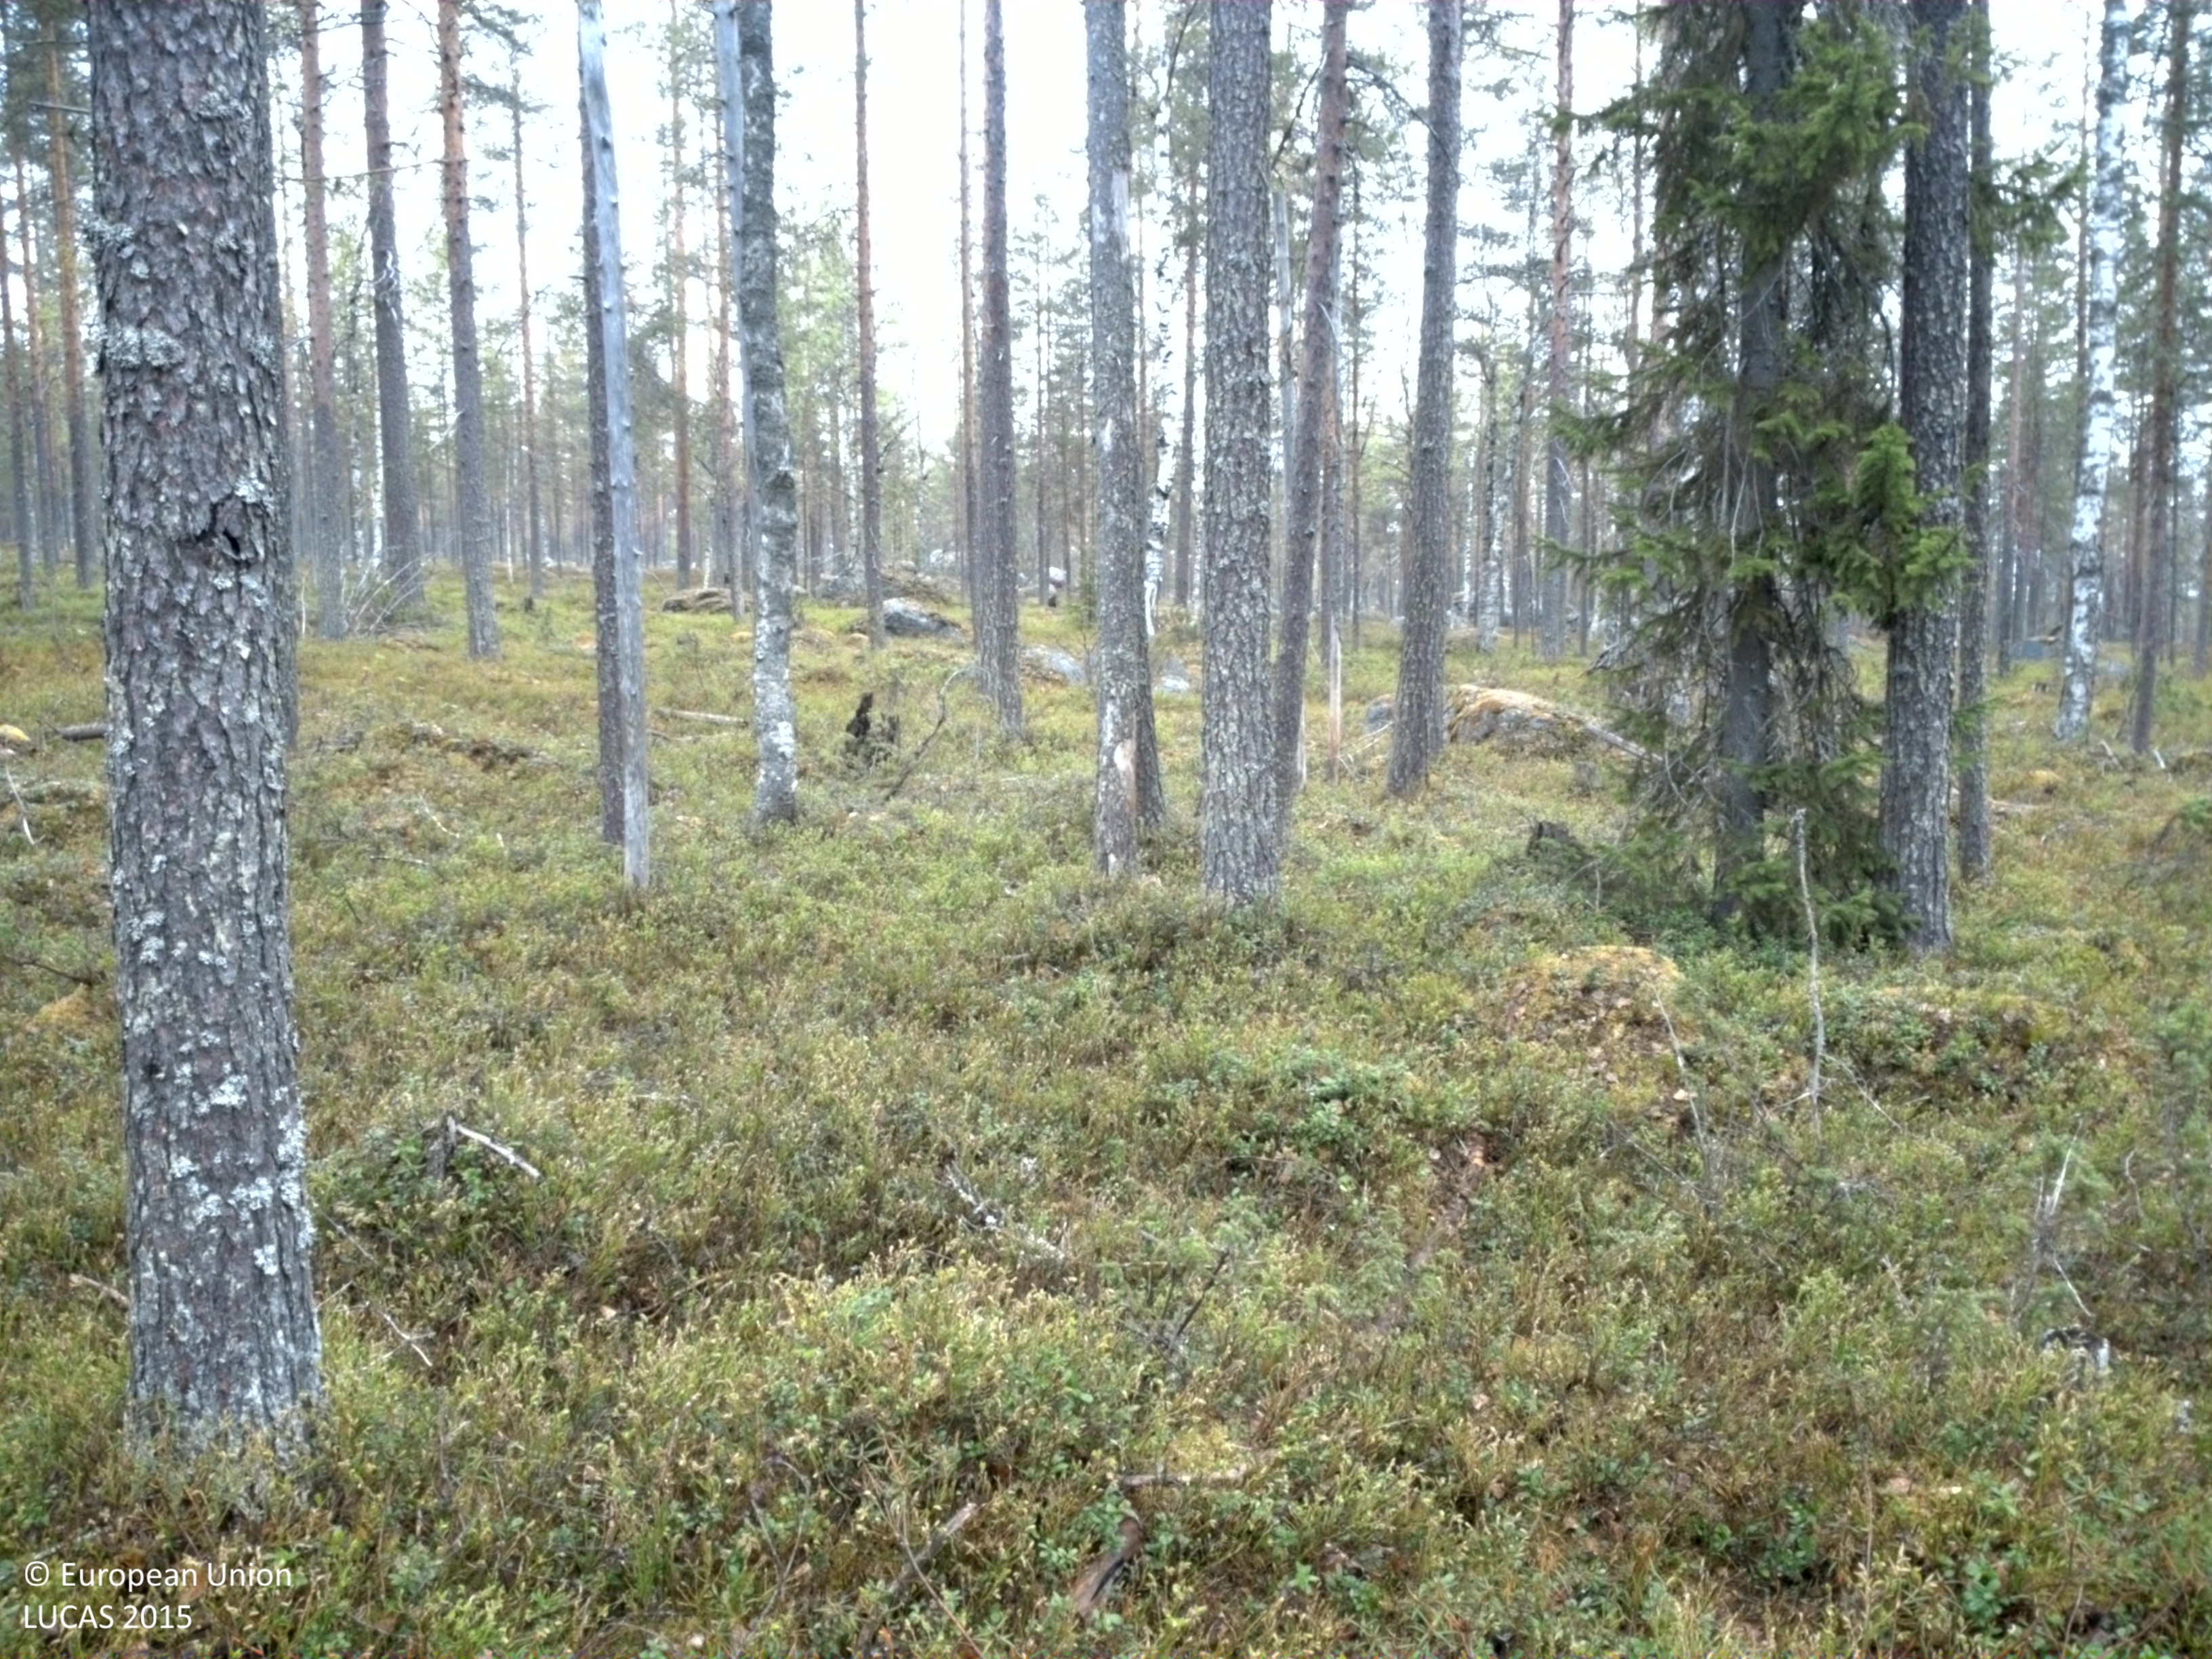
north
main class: Woodland
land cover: Pine dominated coniferous woodland
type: boreal forest
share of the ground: 50 - 75 %
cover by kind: coniferous forest trees 65 %, shrubs 30 %, broadleaved forest trees 5 %
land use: Forestry
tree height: > 5 m
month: May
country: SE
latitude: 66.0388
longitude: 23.3386
